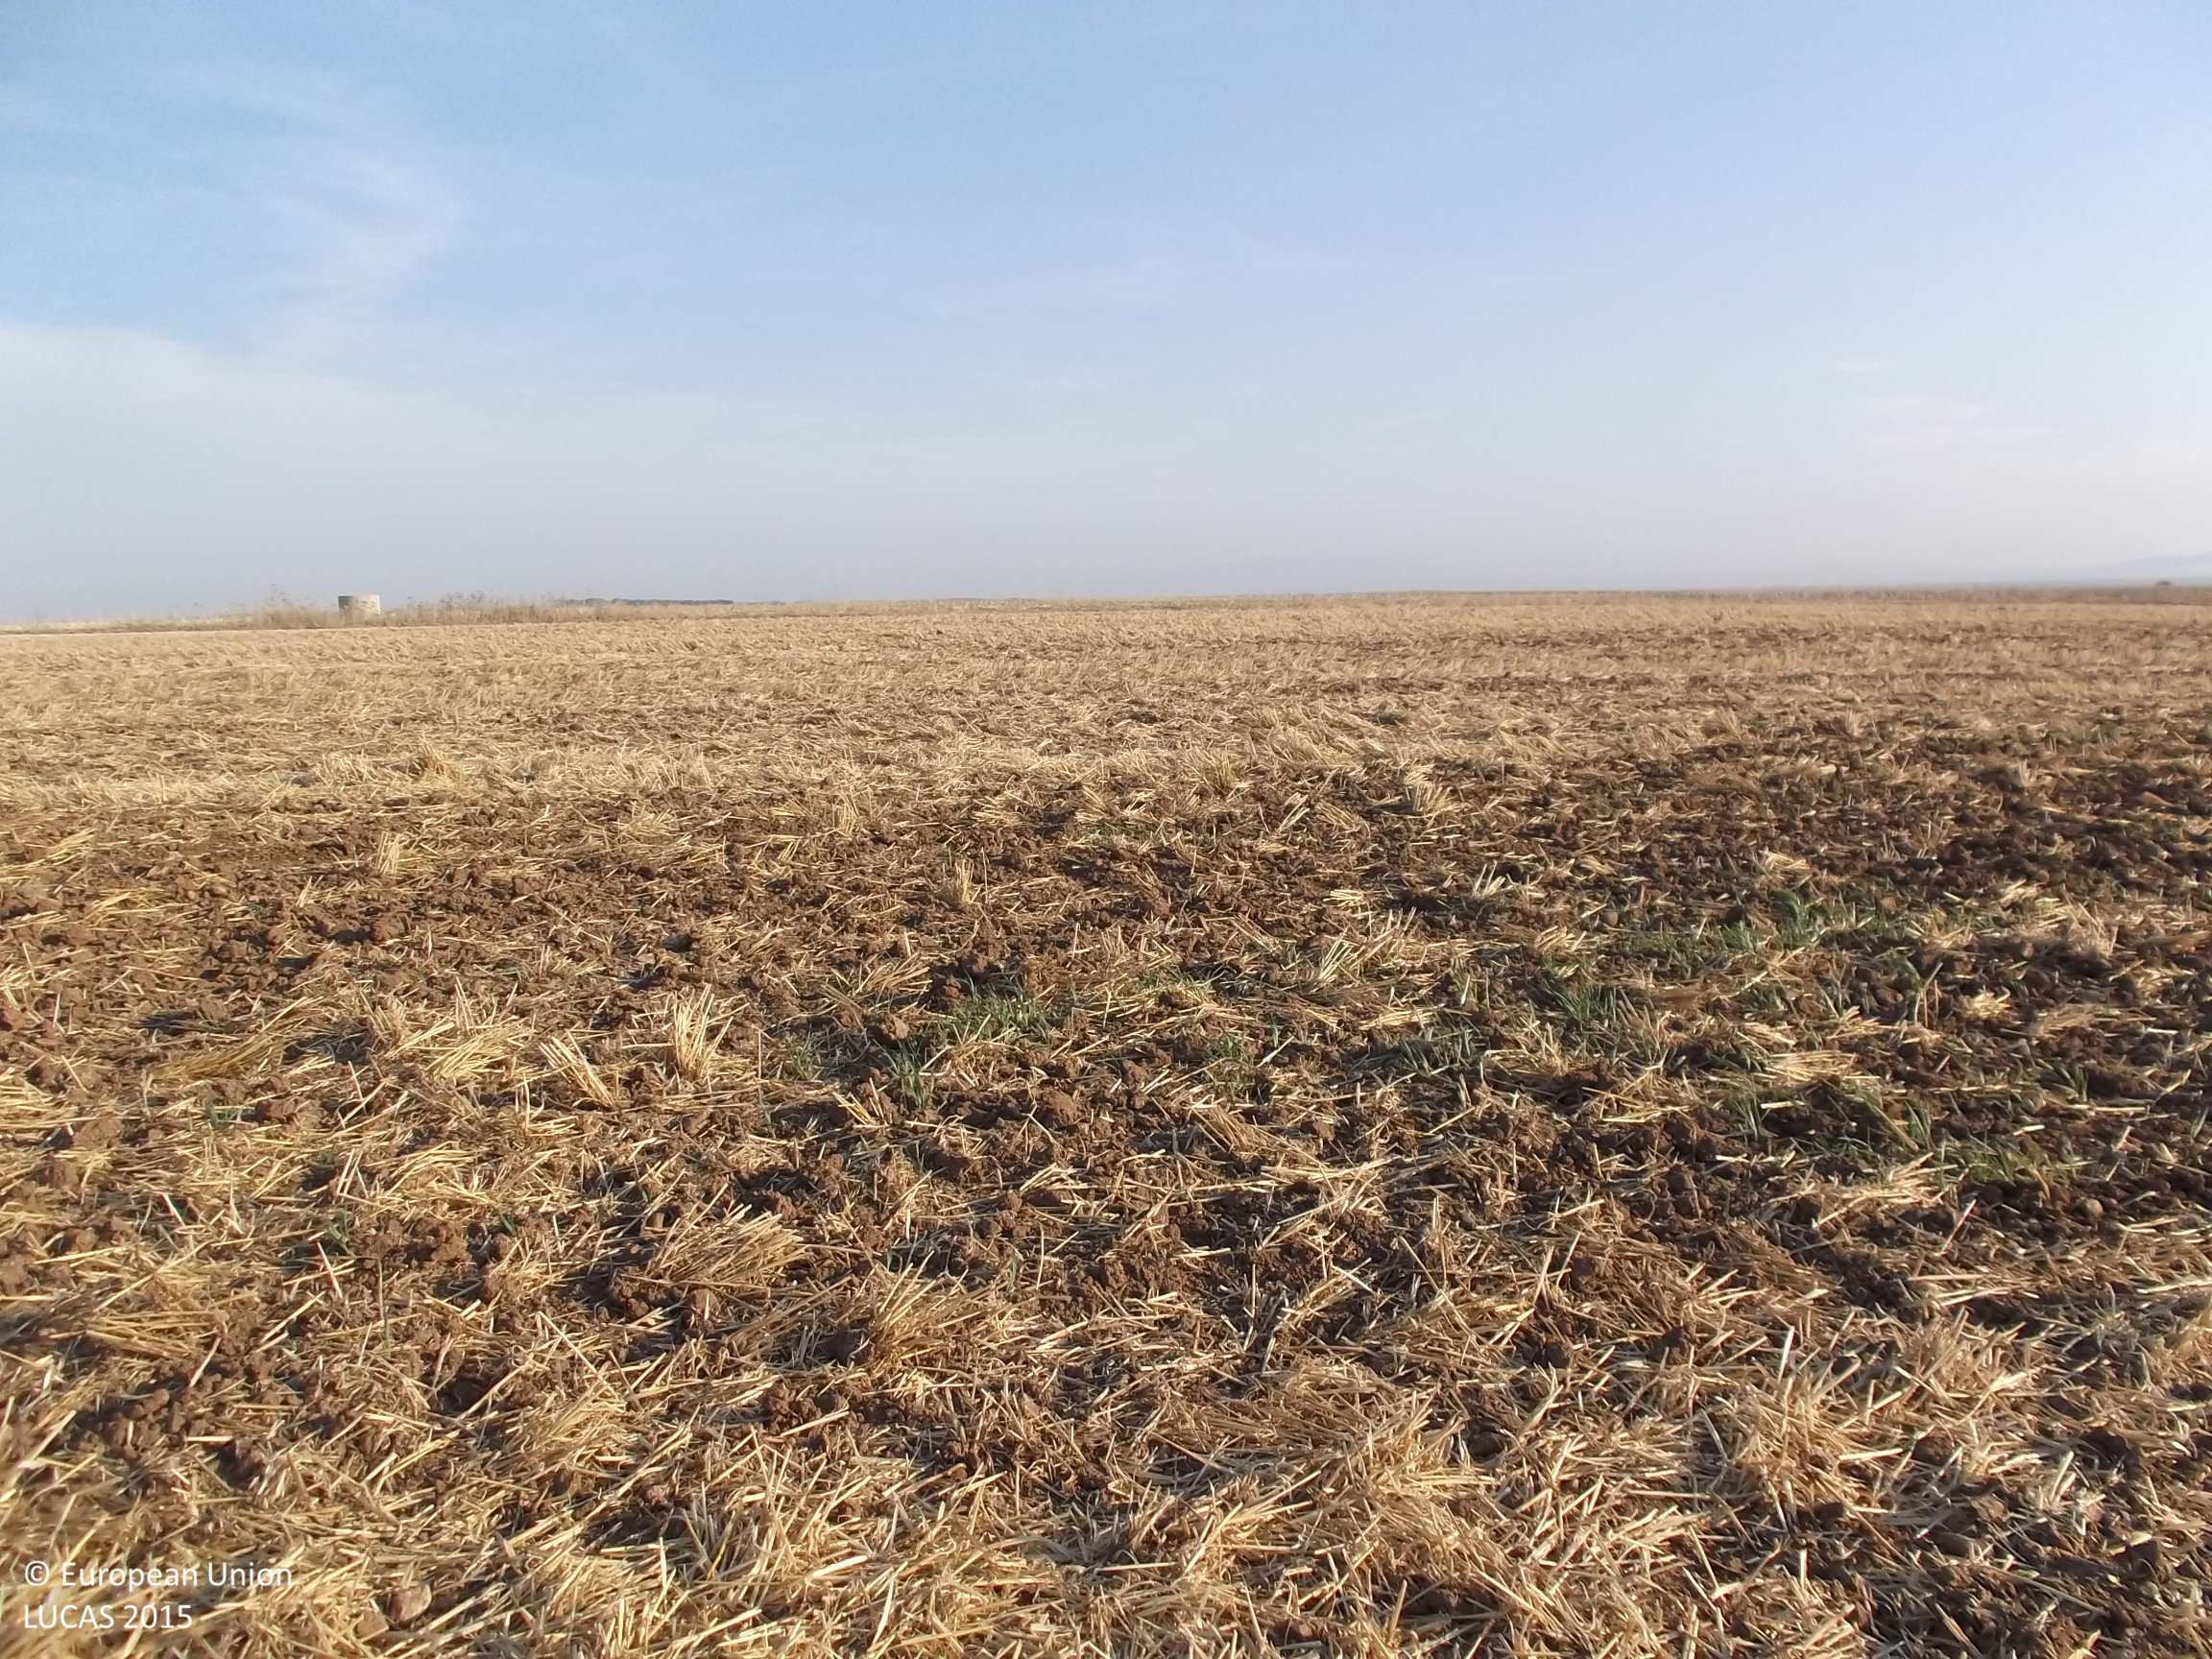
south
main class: Cropland
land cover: Barley
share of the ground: < 10 %
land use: Agriculture (excluding fallow land and kitchen gardens)
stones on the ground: < 10 %
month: July
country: ES
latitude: 42.3944
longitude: -1.6858
